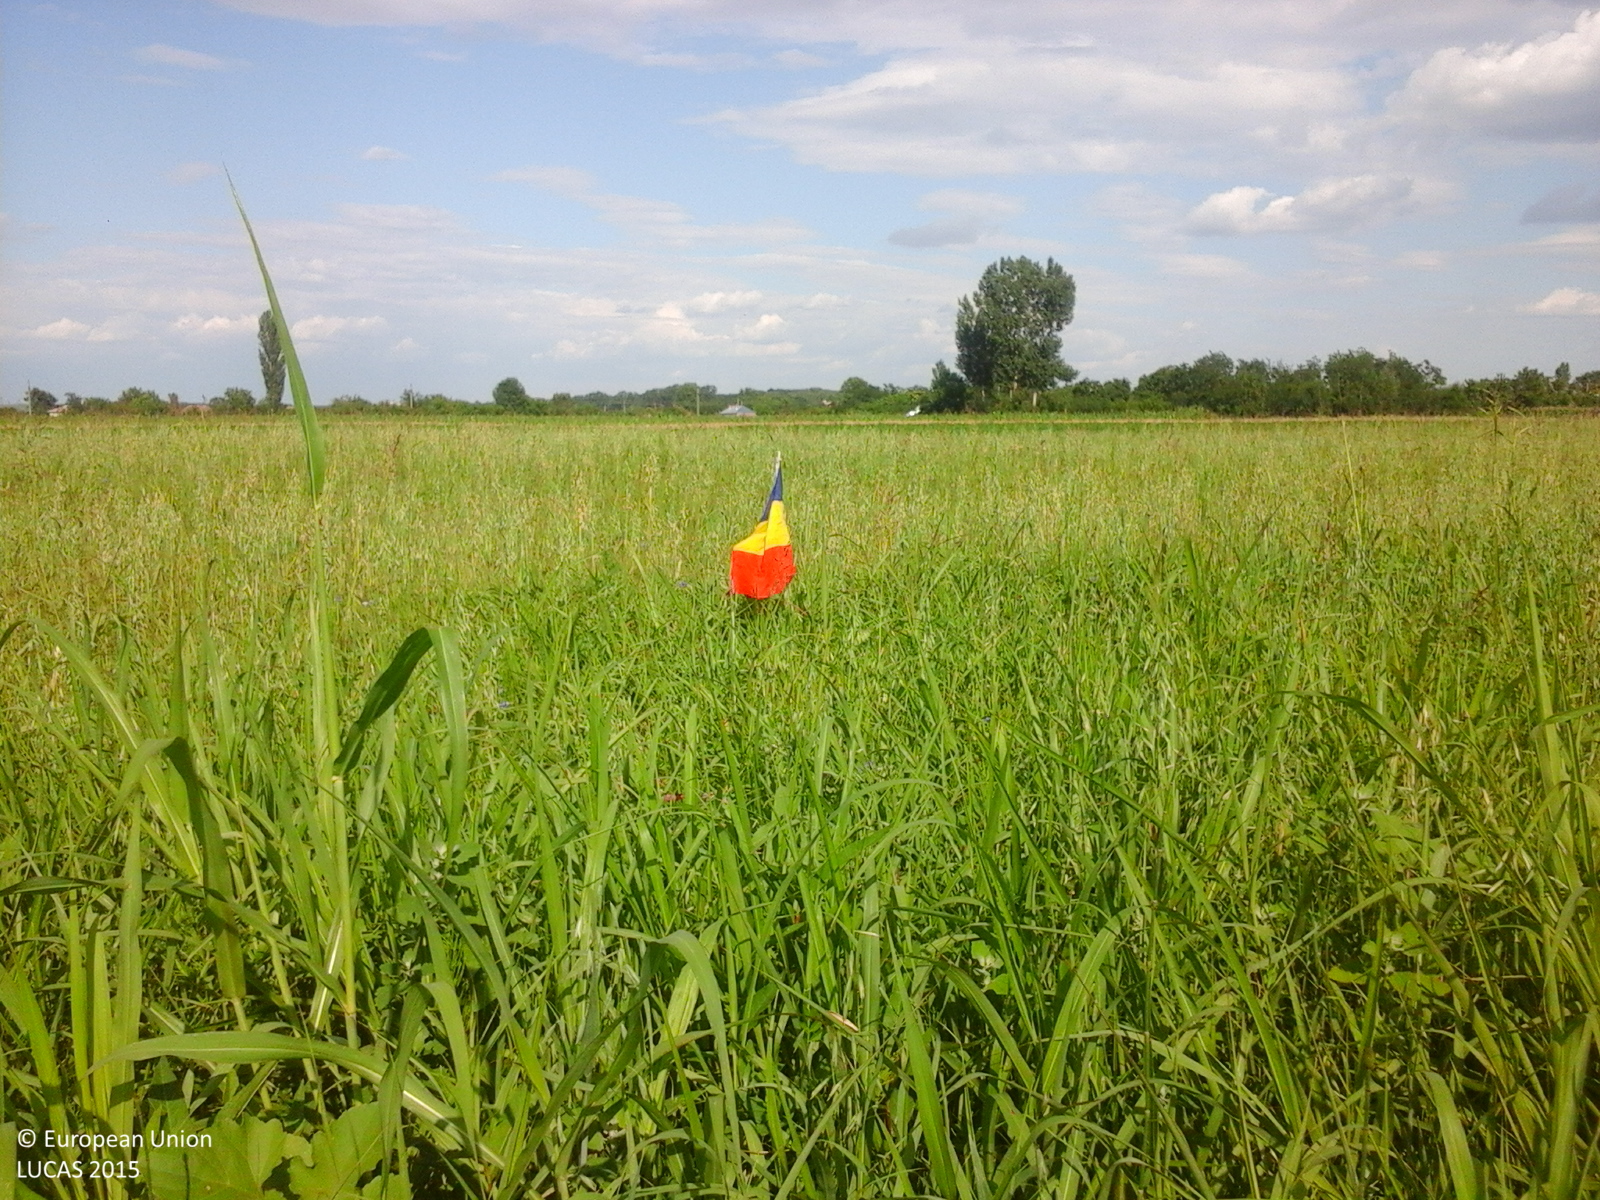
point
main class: Grassland
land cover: Grassland without tree/shrub cover
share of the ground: > 75 %
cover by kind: herbaceous plants 100 %
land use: Agriculture (excluding fallow land and kitchen gardens)
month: July
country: RO
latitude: 44.0460
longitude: 24.5833
